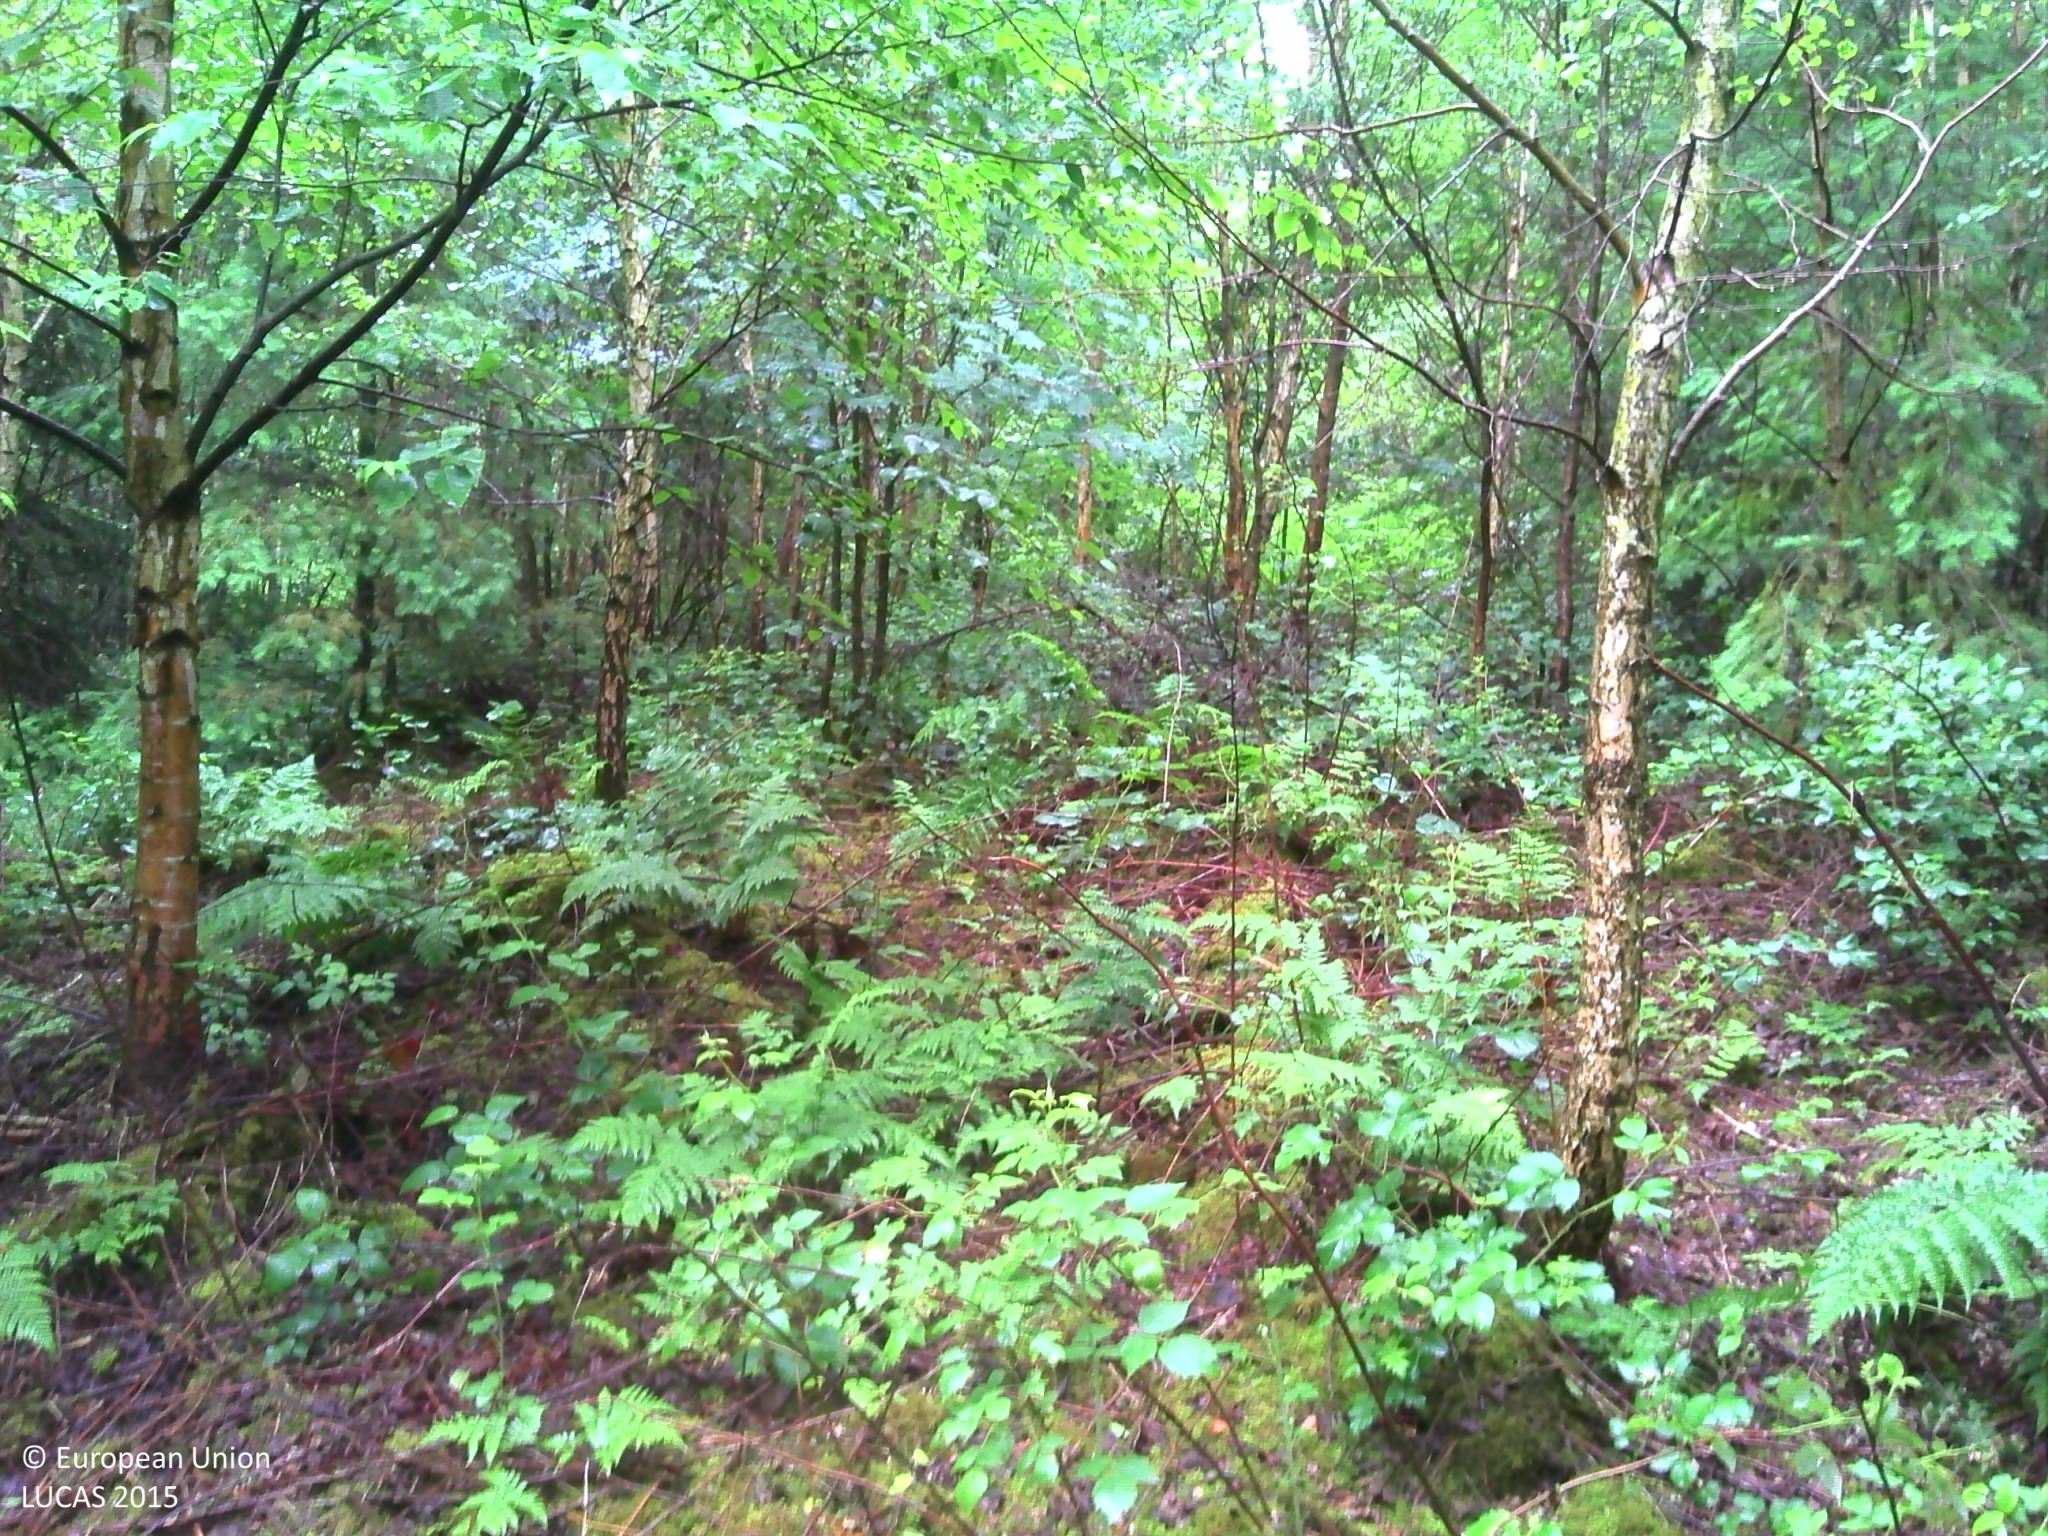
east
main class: Woodland
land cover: Broadleaved woodland
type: acidophilous oak and oak-birch forest
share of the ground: 50 - 75 %
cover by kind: broadleaved forest trees 70 %, shrubs 20 %, herbaceous plants 10 %
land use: Forestry
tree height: > 5 m
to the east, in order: Broadleaved woodland; Tracks; Broadleaved woodland; Other coniferous woodland; Broadleaved woodland
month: June
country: BE
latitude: 50.2035
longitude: 5.5009
